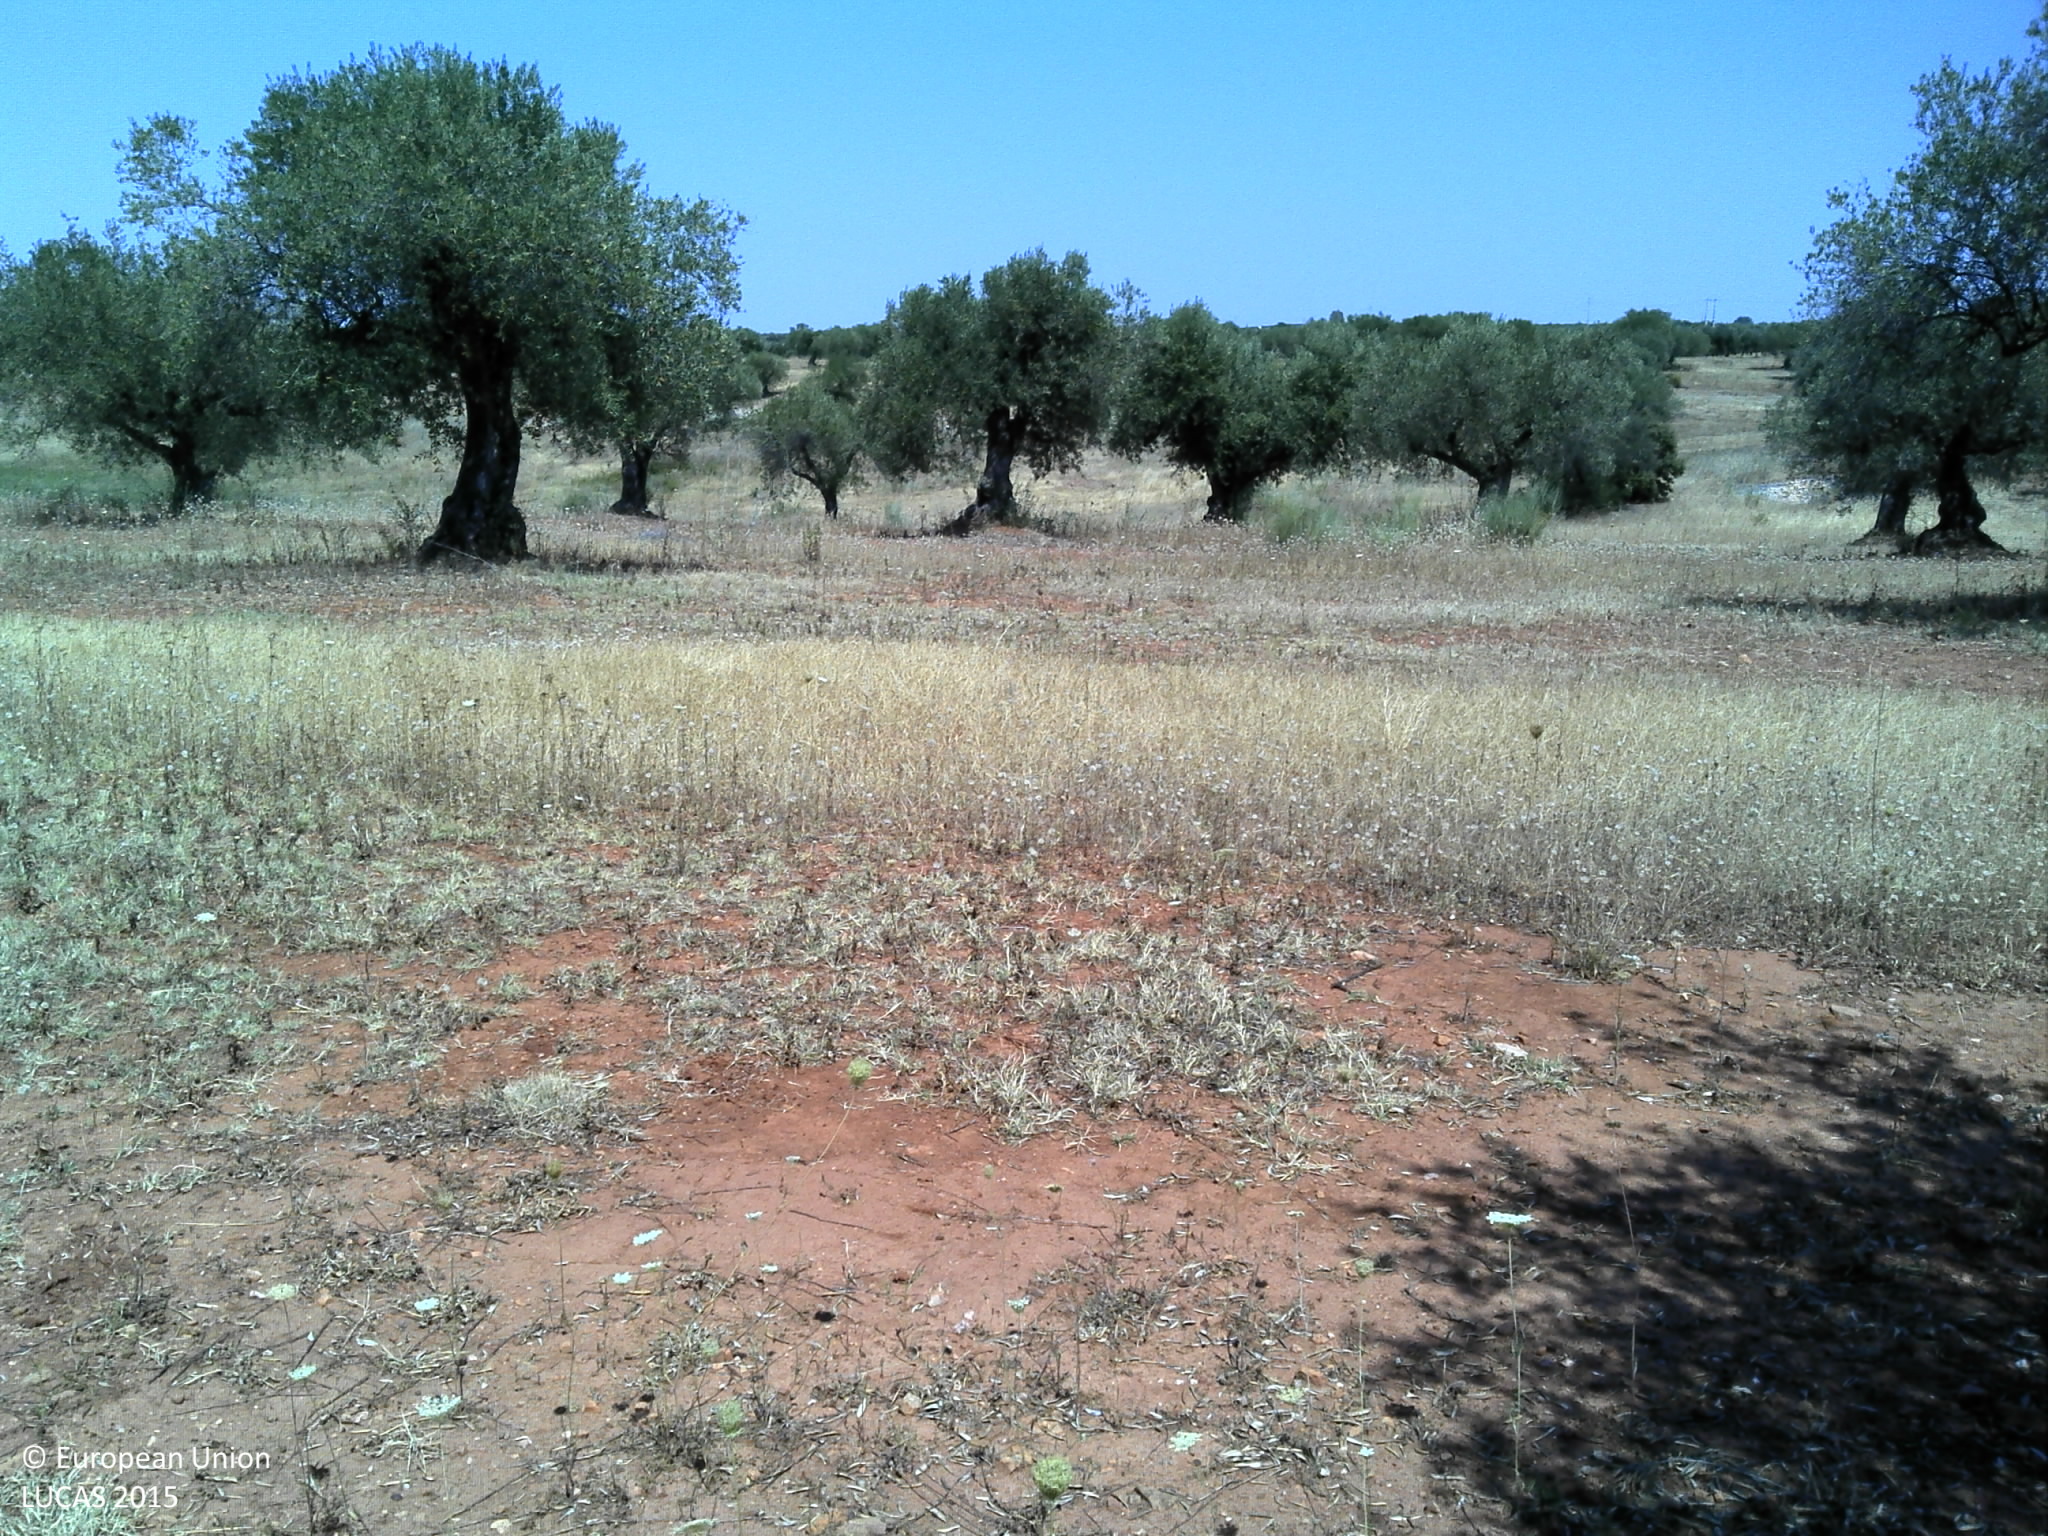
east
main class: Cropland
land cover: Olive groves
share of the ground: 25 - 50 %
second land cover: Grassland without tree/shrub cover
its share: 10 - 25 %
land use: Agriculture (excluding fallow land and kitchen gardens)
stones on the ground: < 10 %
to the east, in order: Olive groves; Grassland without tree/shrub cover; Olive groves; Tracks; Olive groves; Grassland without tree/shrub cover; Olive groves
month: June
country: PT
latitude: 38.0553
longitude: -7.5841
